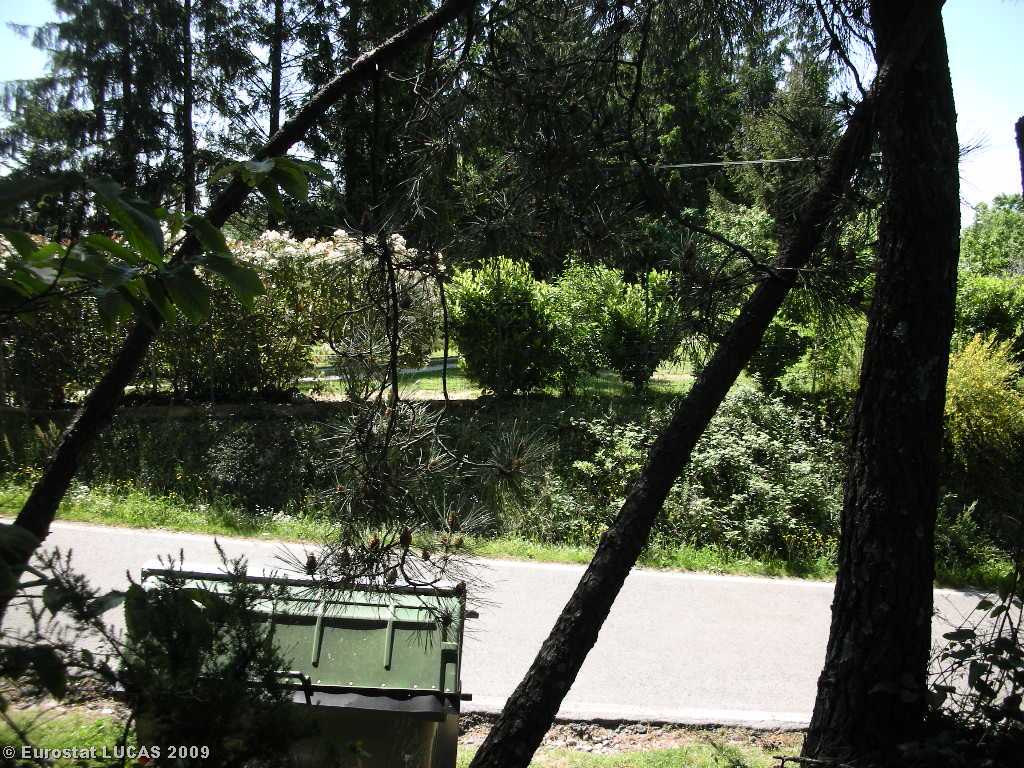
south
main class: Woodland
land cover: Mixed woodland
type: thermophilous deciduous forest
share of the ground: > 75 %
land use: Forestry
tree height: > 5 m
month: May
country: IT
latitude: 43.9325
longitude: 10.8076
